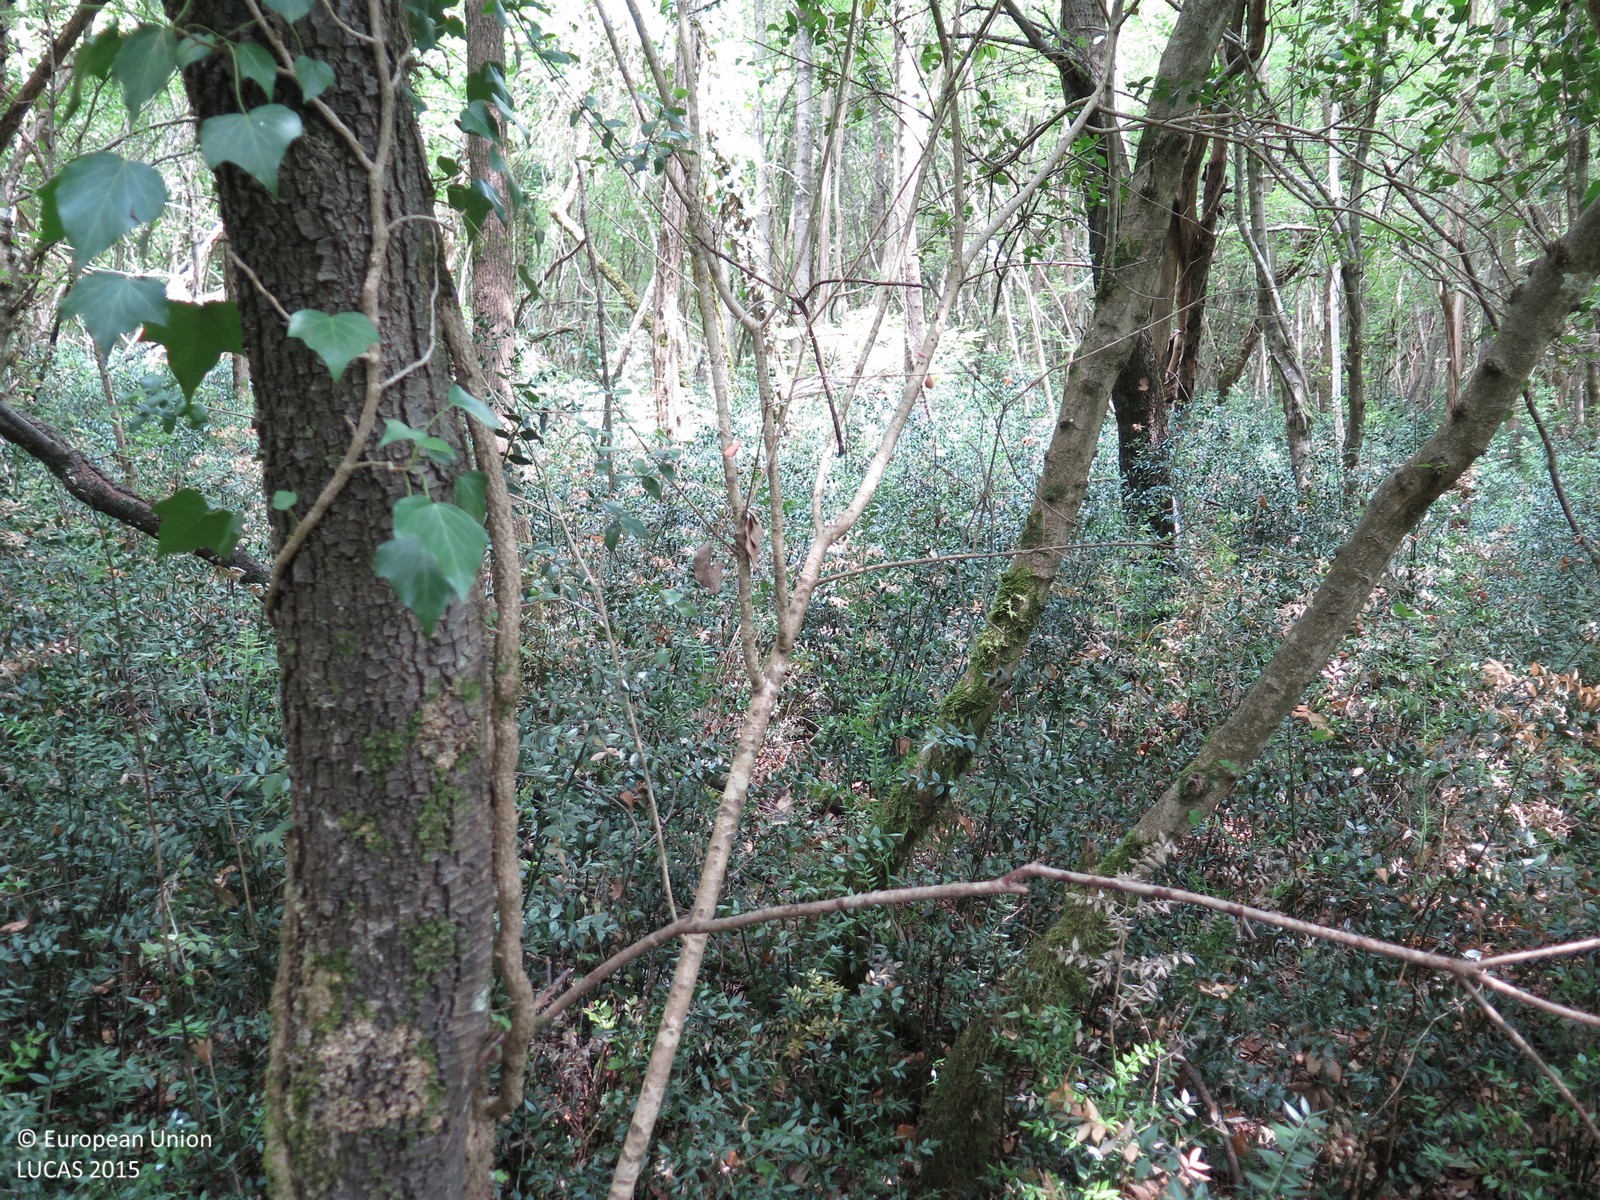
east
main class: Woodland
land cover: Broadleaved woodland
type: mesophytic deciduous forest
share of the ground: > 75 %
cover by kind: broadleaved forest trees 95 %, shrubs 5 %
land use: Semi-natural and natural areas not in use
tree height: > 5 m
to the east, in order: Broadleaved woodland; Tracks; Broadleaved woodland; Tracks; Dry stone walls; Broadleaved woodland
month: June
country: HR
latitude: 45.1537
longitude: 13.6199
